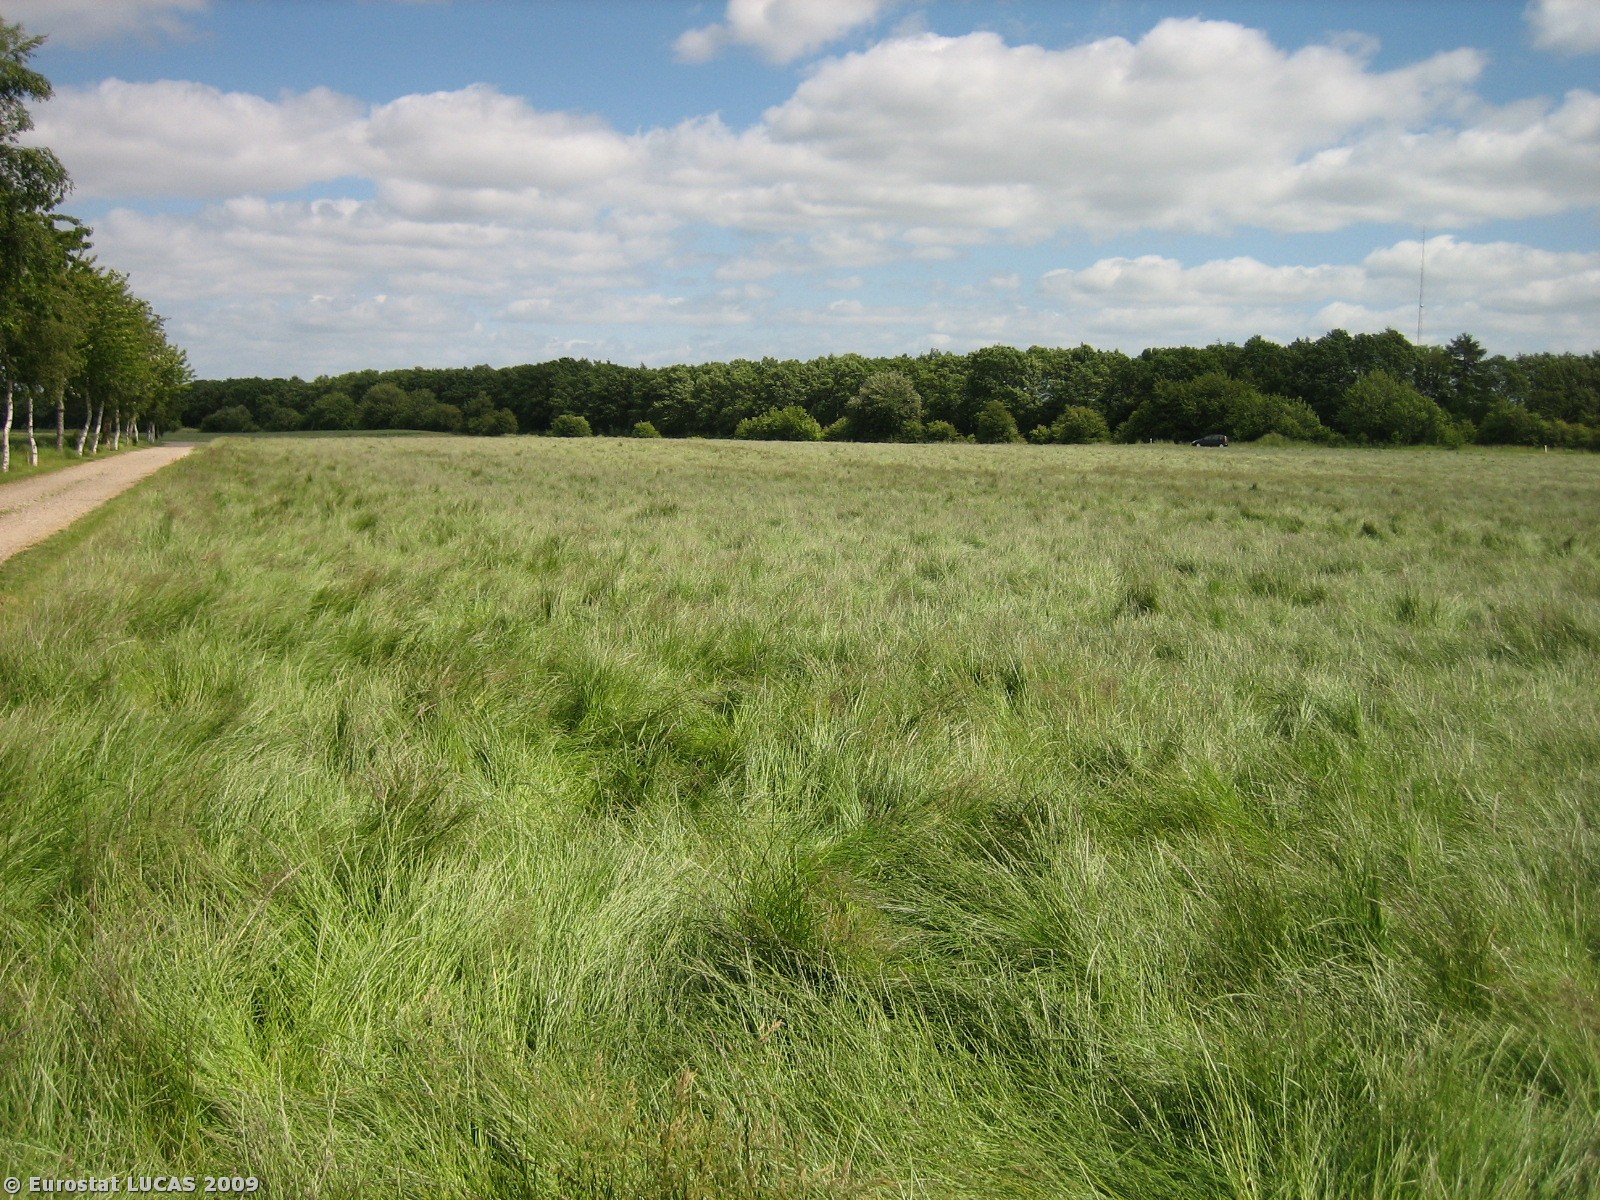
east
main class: Artificial land
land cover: Non built-up linear features
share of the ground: > 75 %
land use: Residential
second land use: Road transport
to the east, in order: Temporary grasslands; Grass margins; Paved roads, cycling and walking lanes; Grass margins; Temporary grasslands
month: June
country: DK
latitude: 55.8279
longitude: 9.7289
